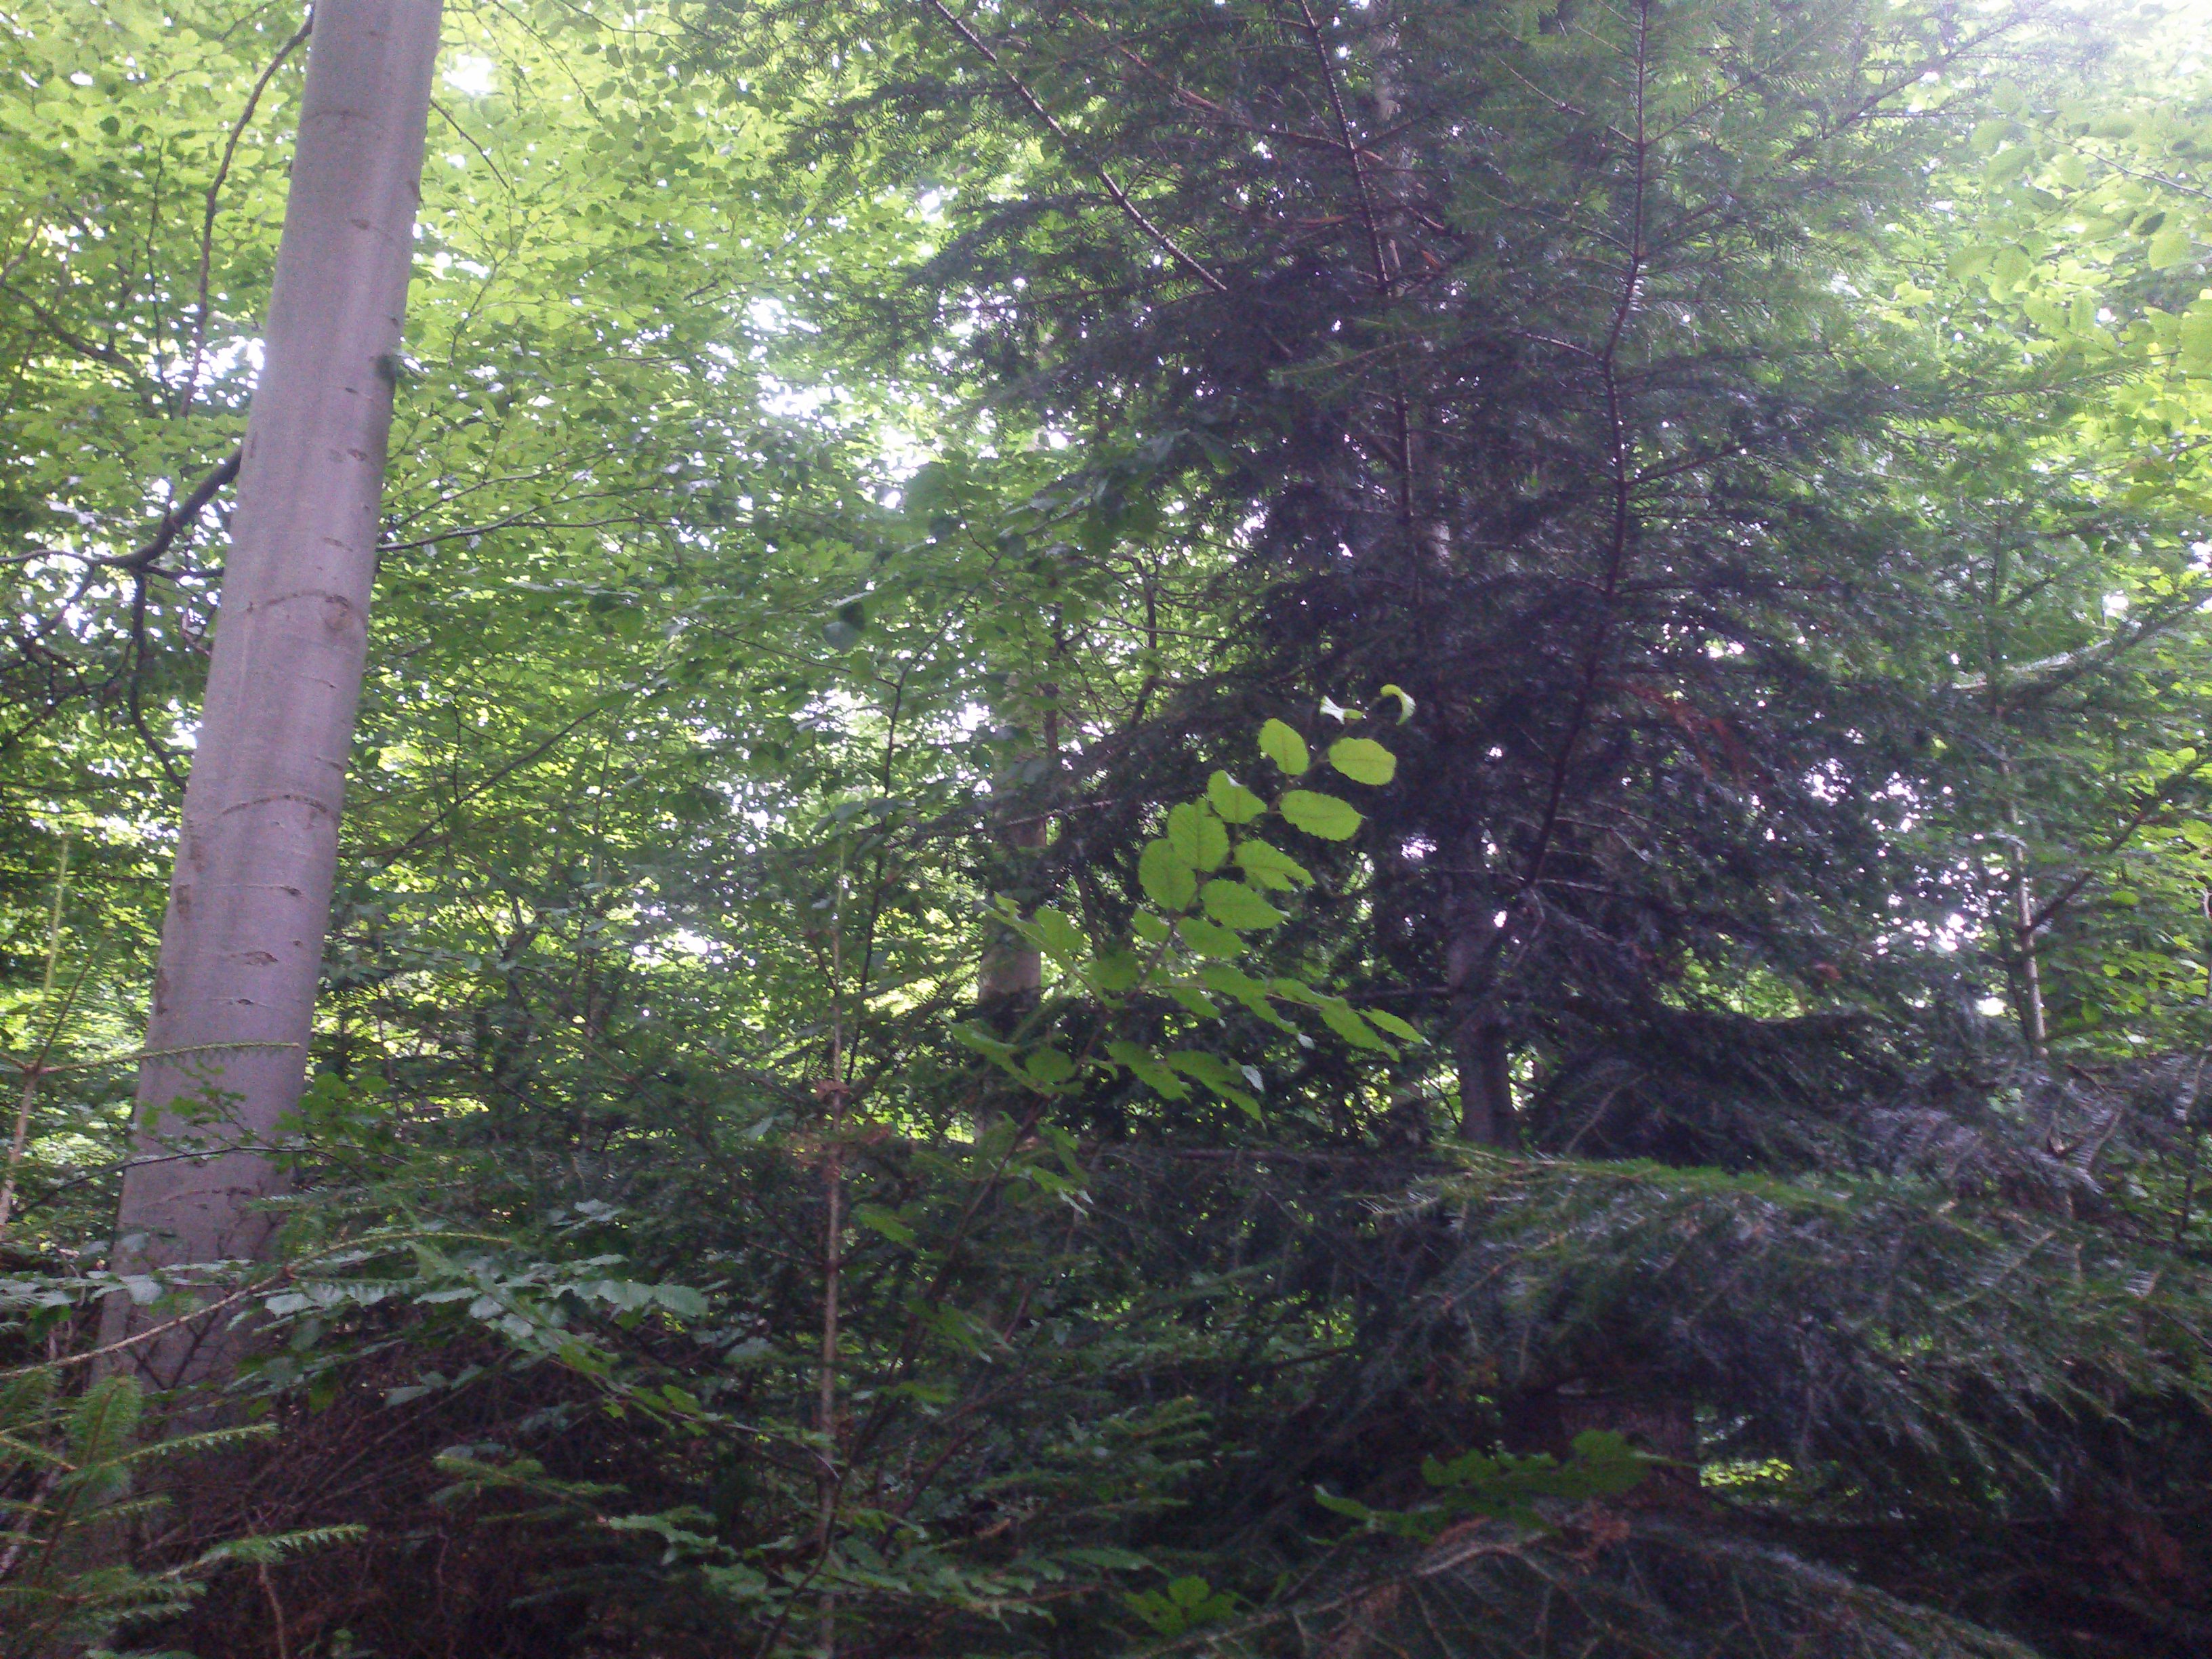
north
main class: Woodland
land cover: Other mixed woodland
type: hemiboreal forest and nemoral coniferous forest and mixed broadleaved-coniferous forest
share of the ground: > 75 %
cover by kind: broadleaved forest trees 50 %, coniferous forest trees 30 %, unconsolidated bare surface 10 %, shrubs 5 %, herbaceous plants 5 %
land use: Forestry
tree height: > 5 m
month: July
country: PL
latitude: 49.7381
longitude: 22.2576
